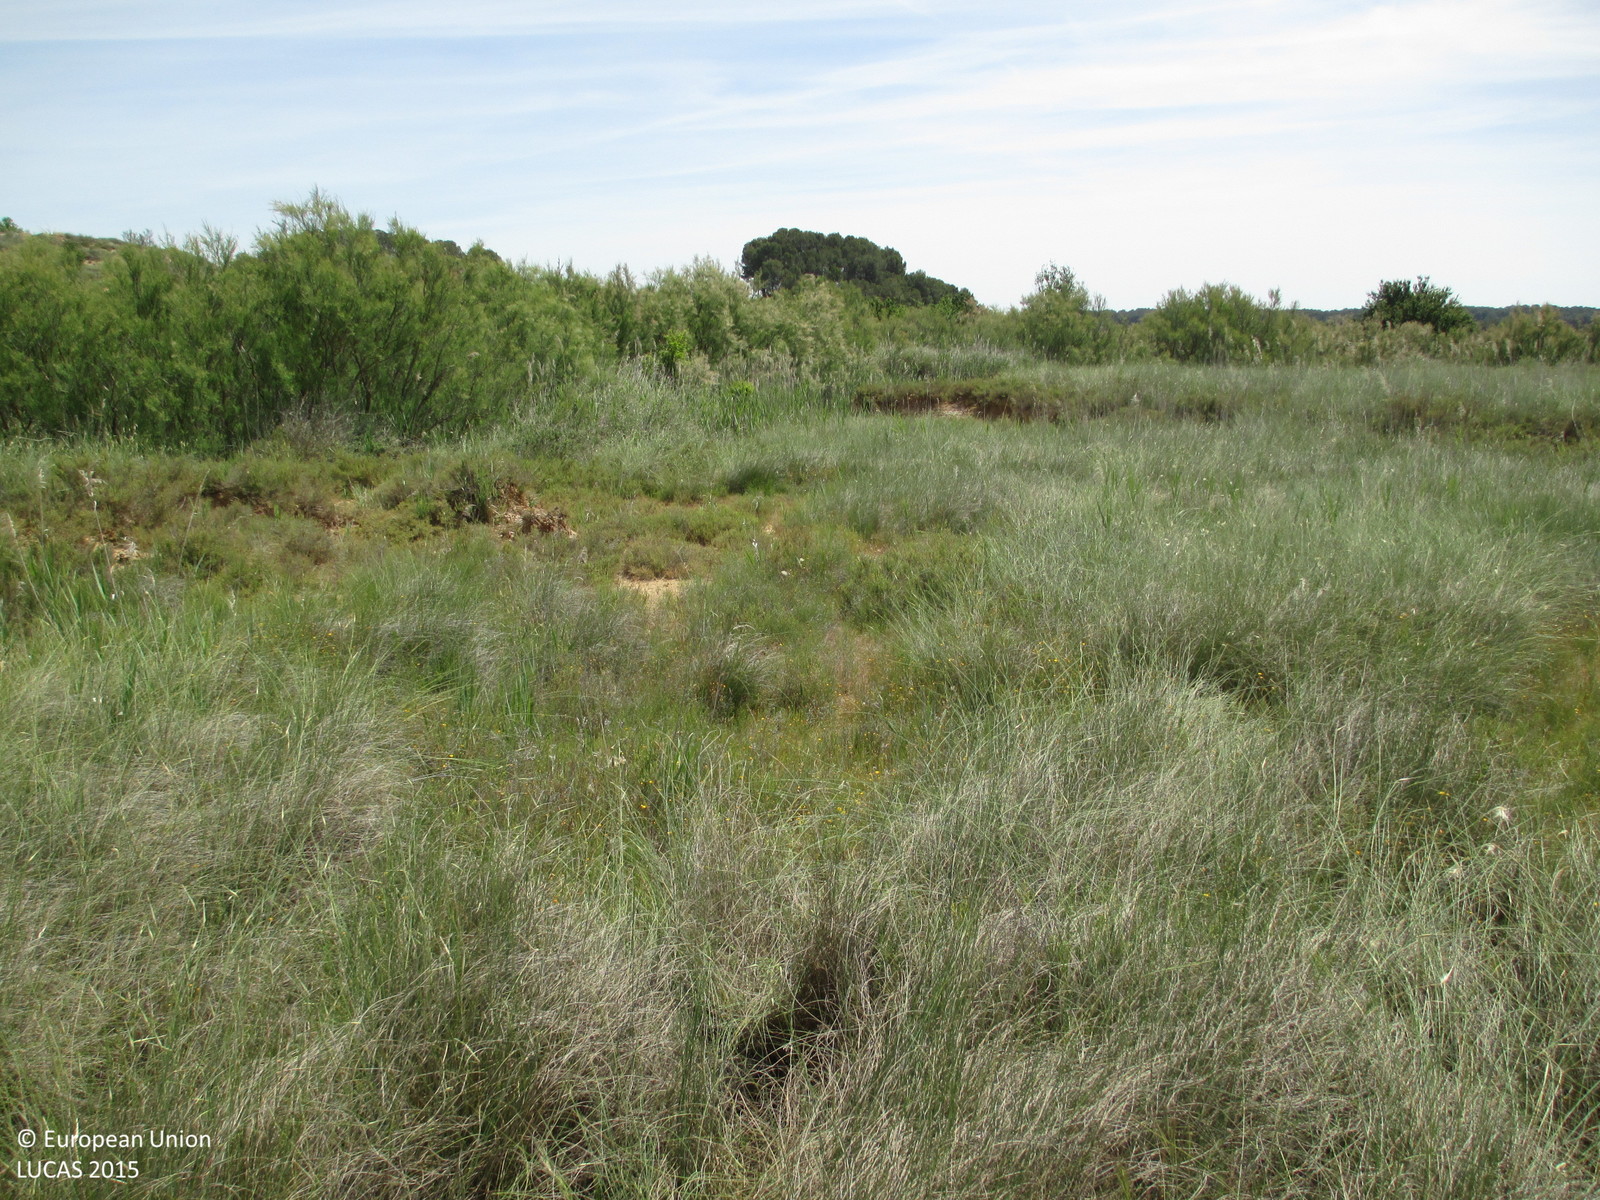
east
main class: Shrubland
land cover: Shrubland without tree cover
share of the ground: > 75 %
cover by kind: shrubs 95 %, herbaceous plants 5 %
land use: Semi-natural and natural areas not in use
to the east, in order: Shrubland without tree cover; Shrubland with sparse tree cover; Rivers and streams; Shrubland with sparse tree cover; Shrubland without tree cover; Tracks; Shruby margins; Dry pulses
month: May
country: ES
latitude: 41.8836
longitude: -0.3718
